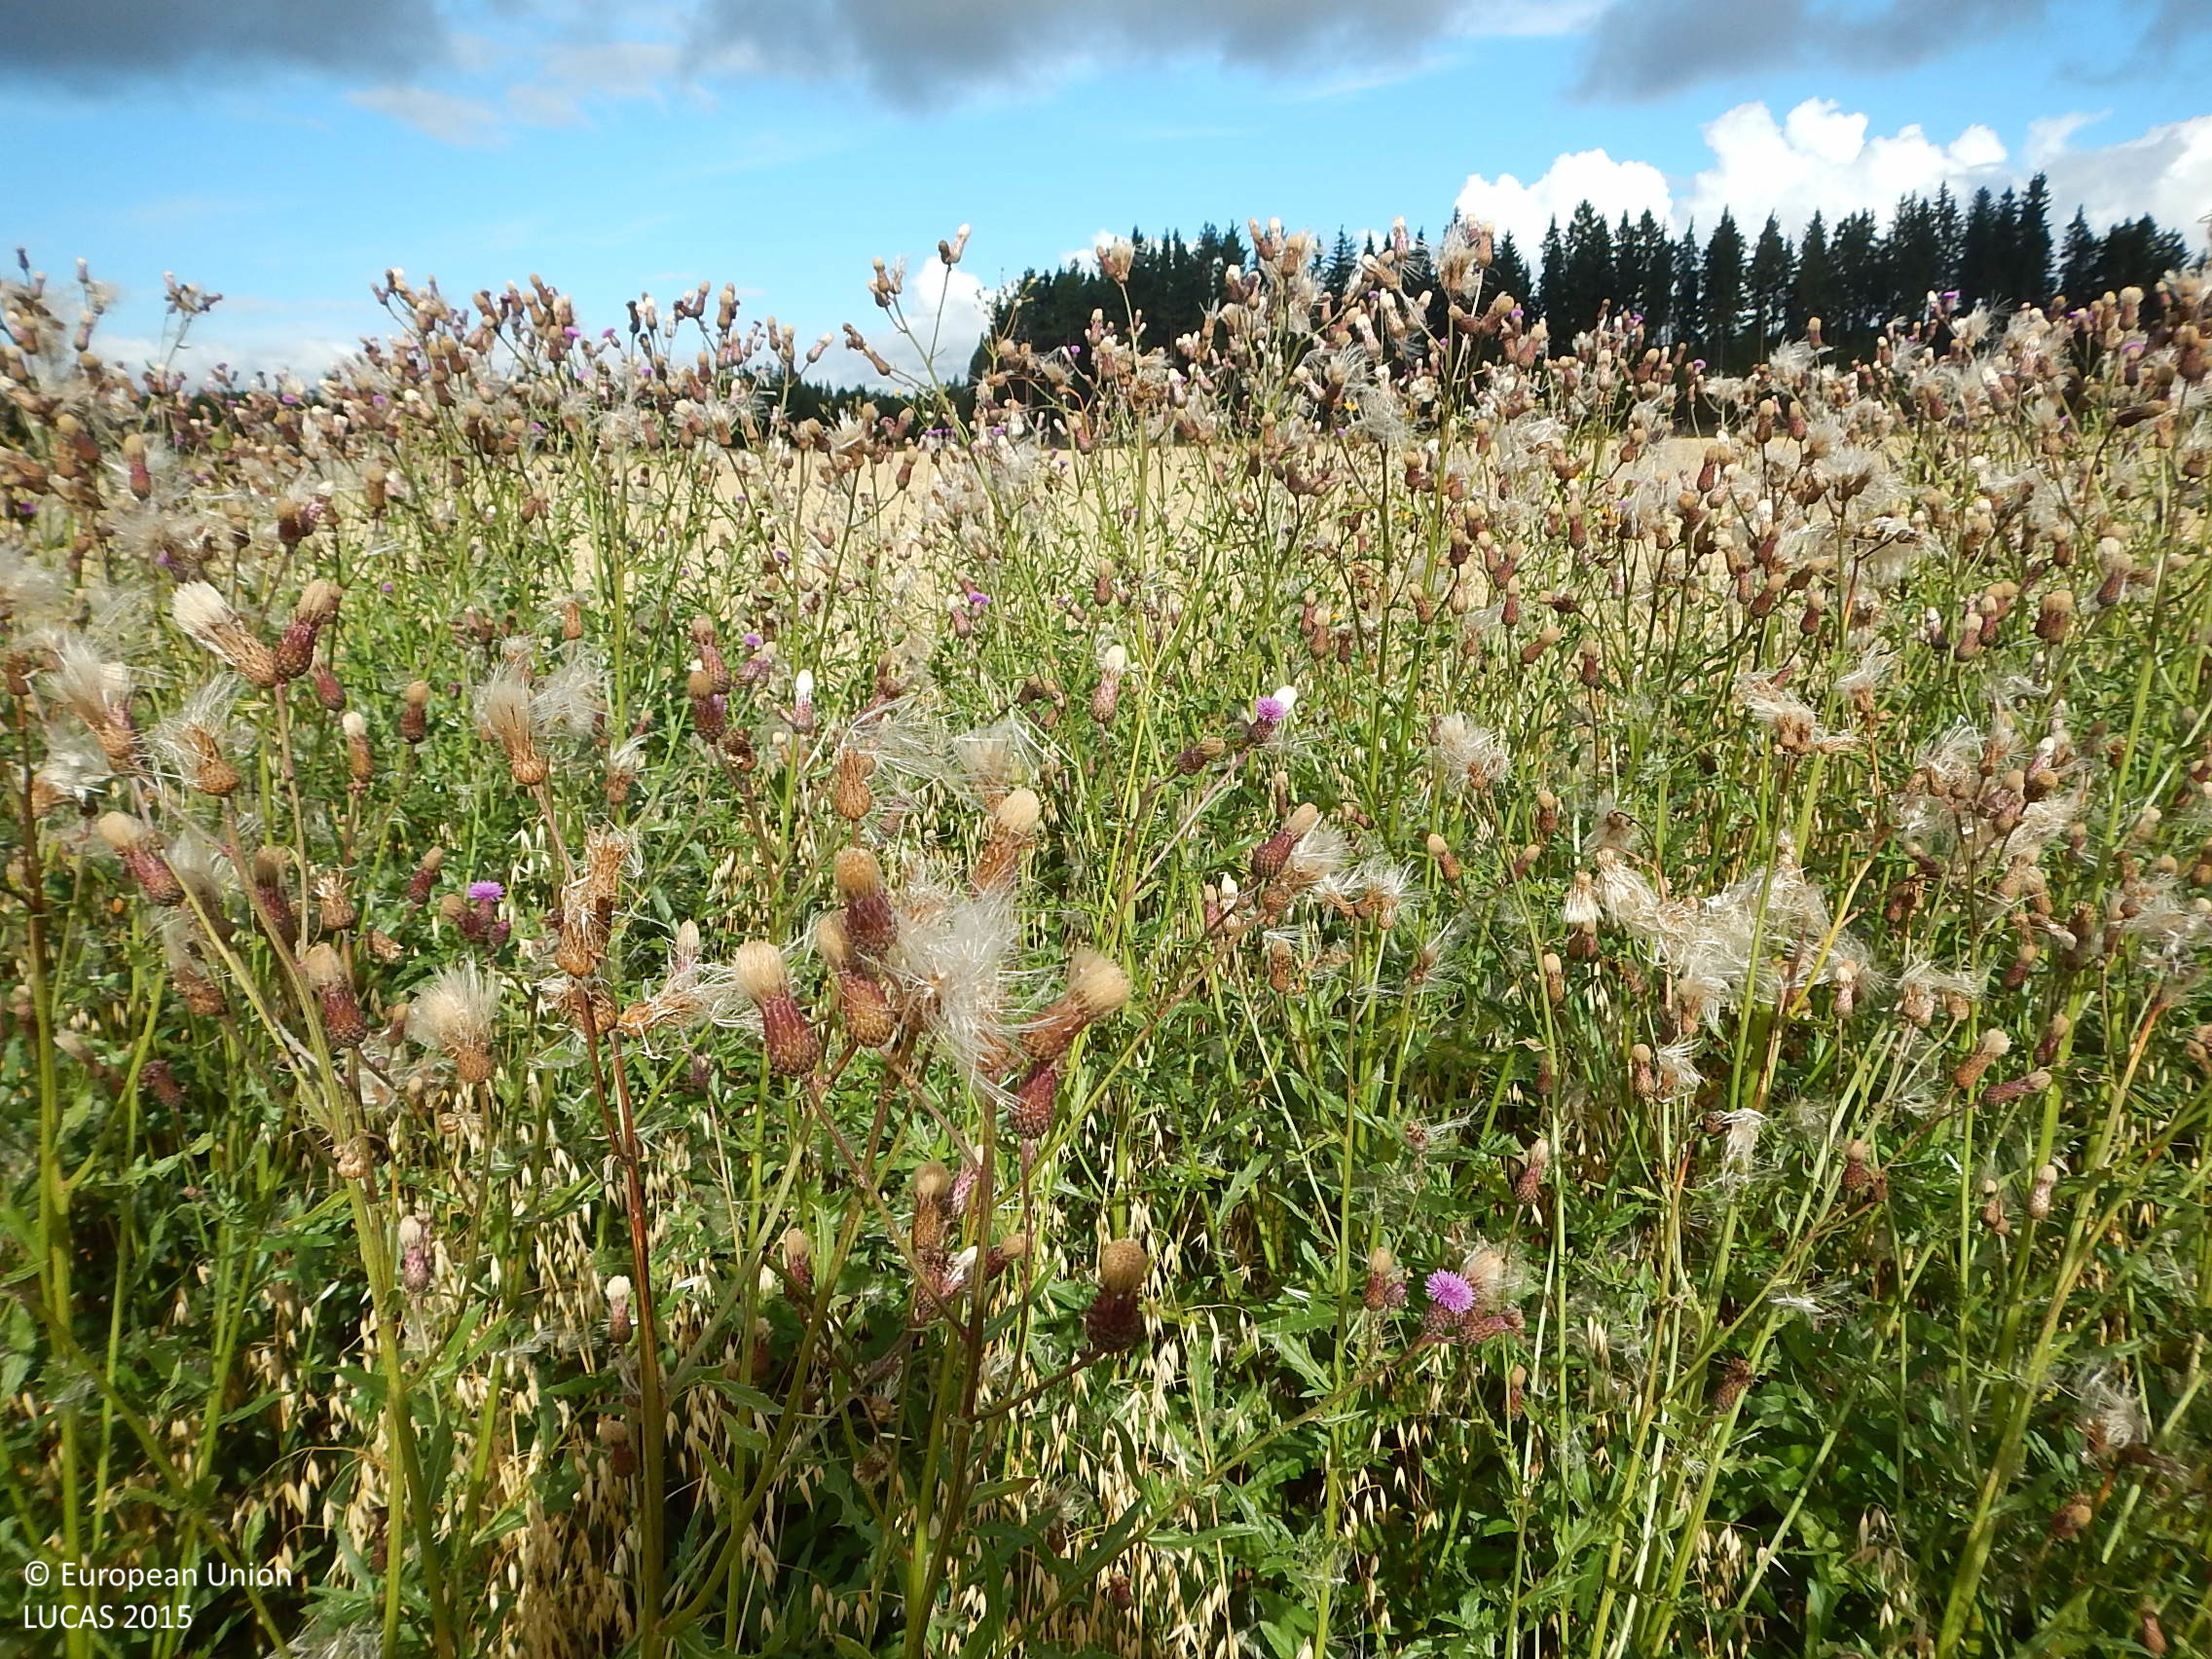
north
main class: Cropland
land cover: Oats
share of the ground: > 75 %
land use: Agriculture (excluding fallow land and kitchen gardens)
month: September
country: FI
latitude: 61.4156
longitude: 22.0299
